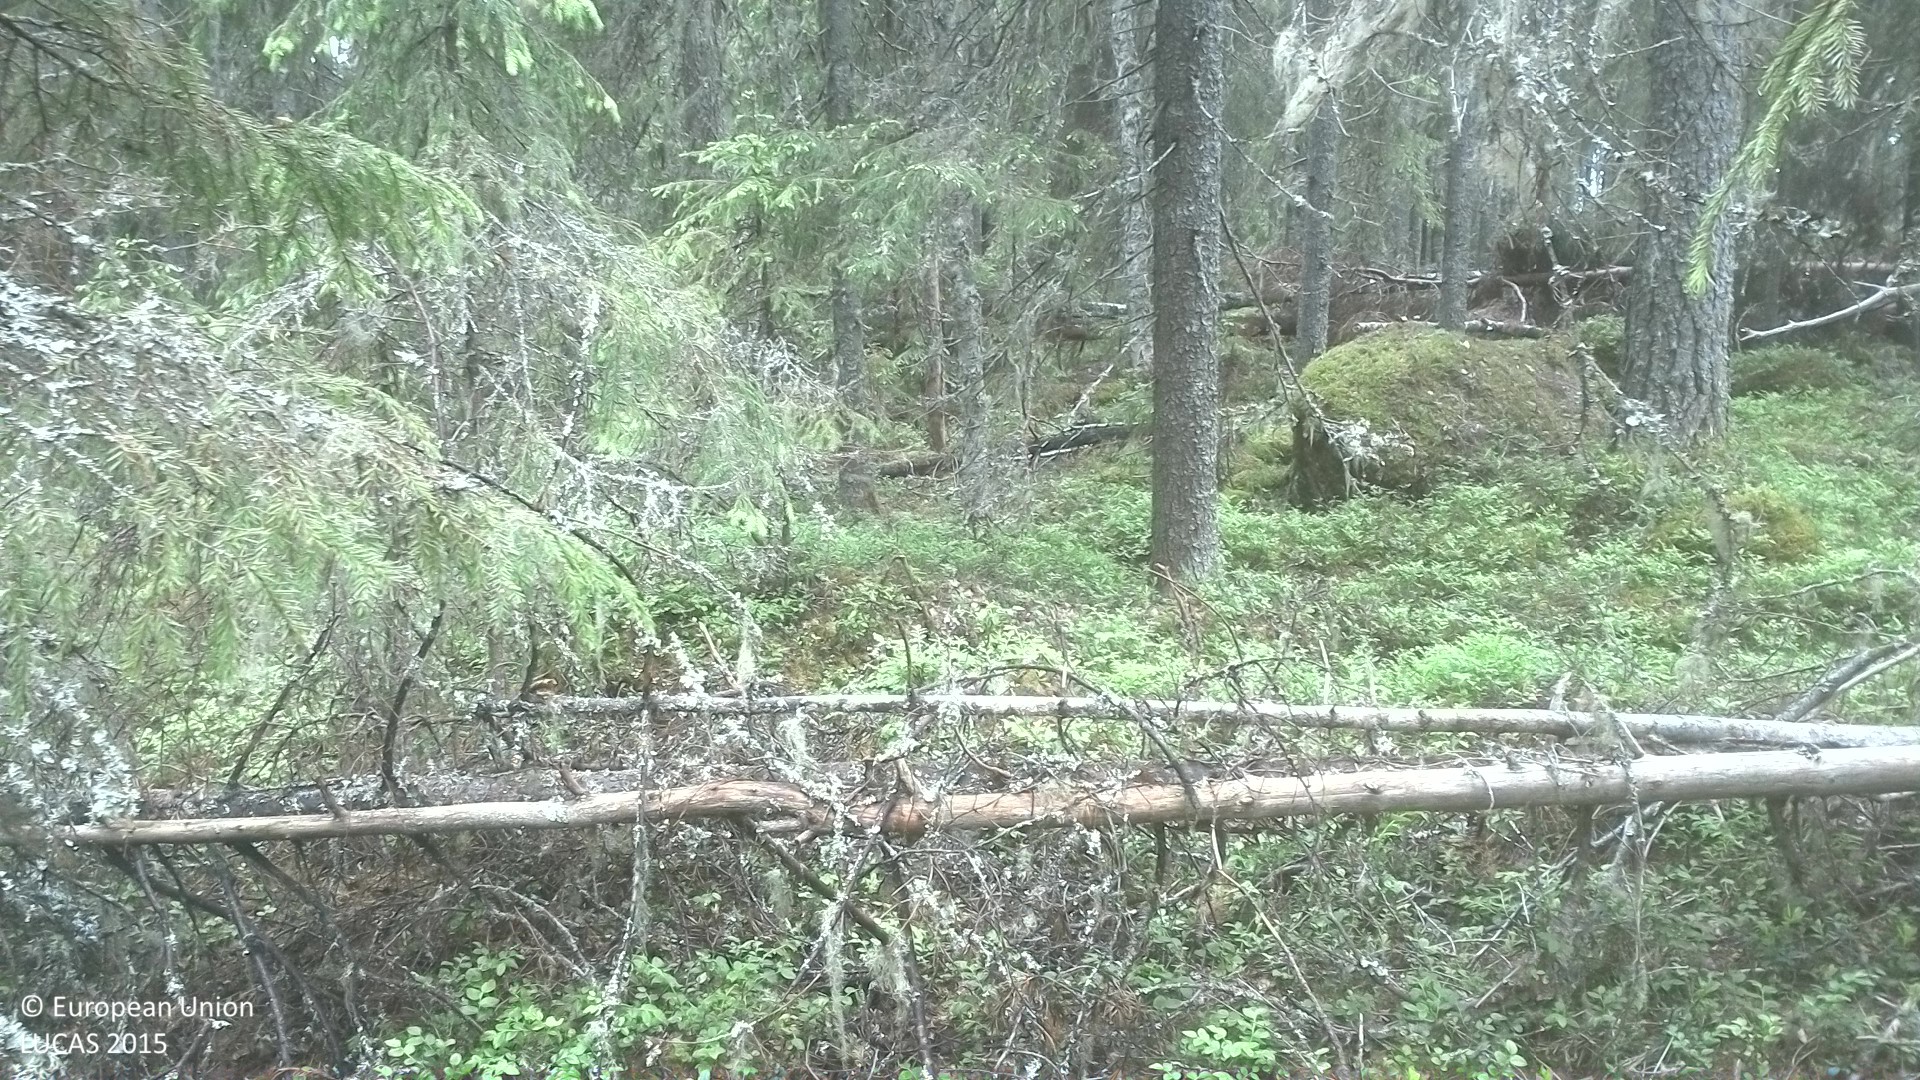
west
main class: Woodland
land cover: Spruce dominated coniferous woodland
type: boreal forest
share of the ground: 50 - 75 %
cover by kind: coniferous forest trees 50 %, shrubs 25 %, lichens and mosses 20 %, herbaceous plants 5 %
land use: Forestry
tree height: > 5 m
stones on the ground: 25 - 50 %
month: June
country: SE
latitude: 62.0565
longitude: 16.8874
